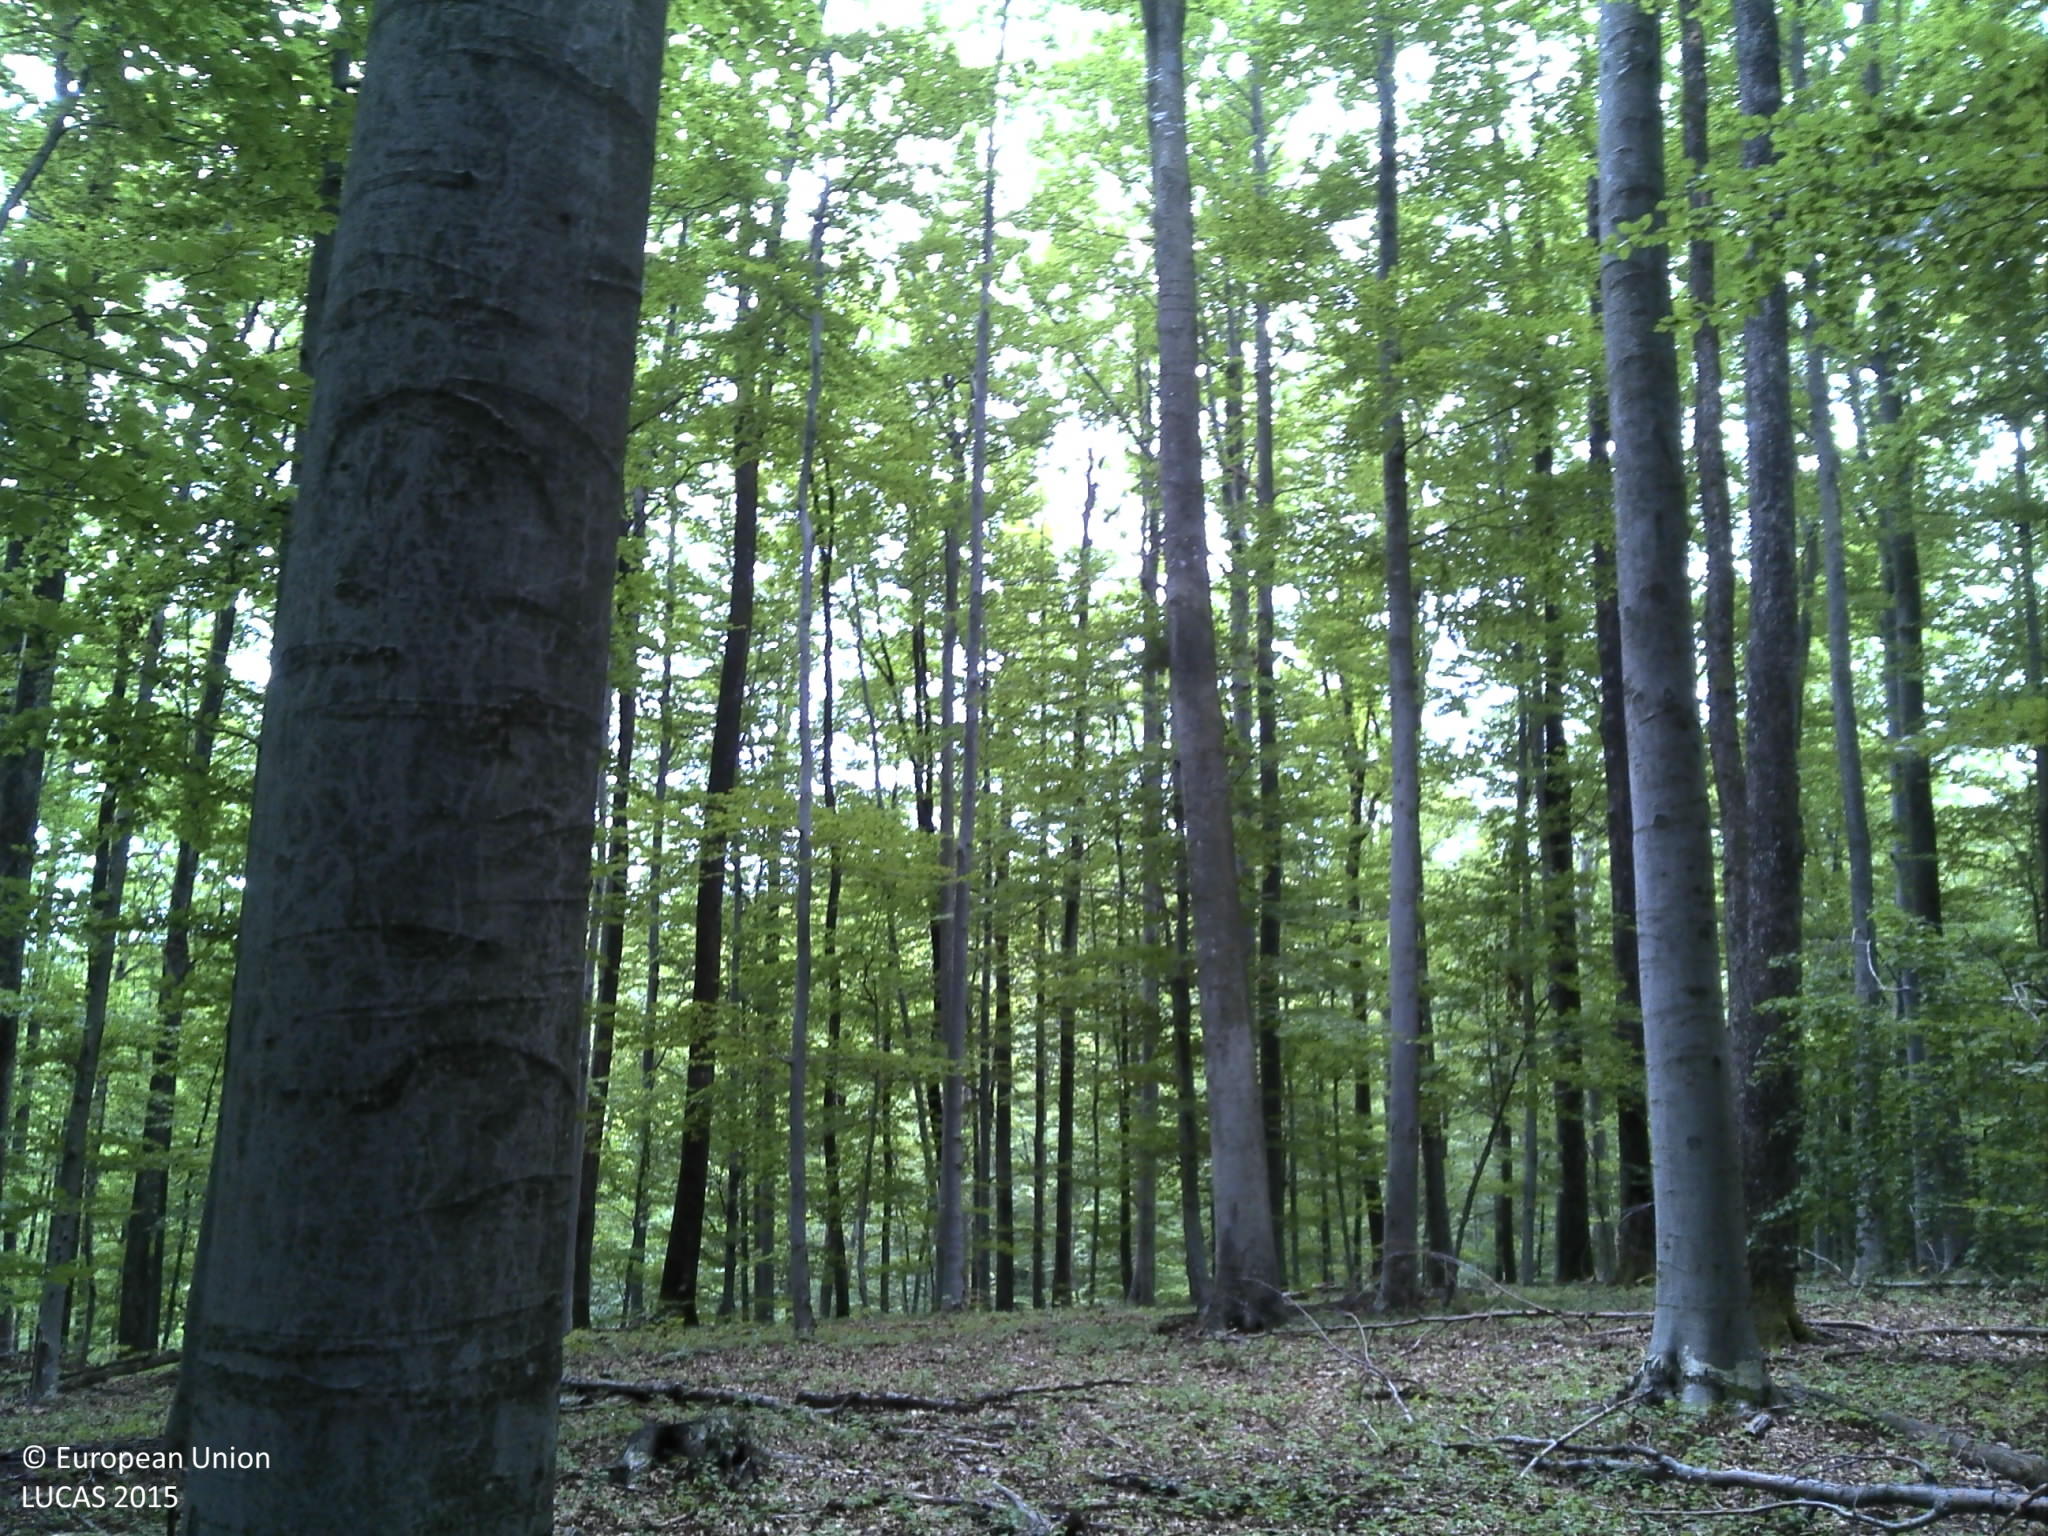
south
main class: Woodland
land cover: Broadleaved woodland
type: beech forest
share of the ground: > 75 %
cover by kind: broadleaved forest trees 100 %
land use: Forestry
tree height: > 5 m
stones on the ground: < 10 %
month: August
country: HR
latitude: 45.3103
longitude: 15.7740
